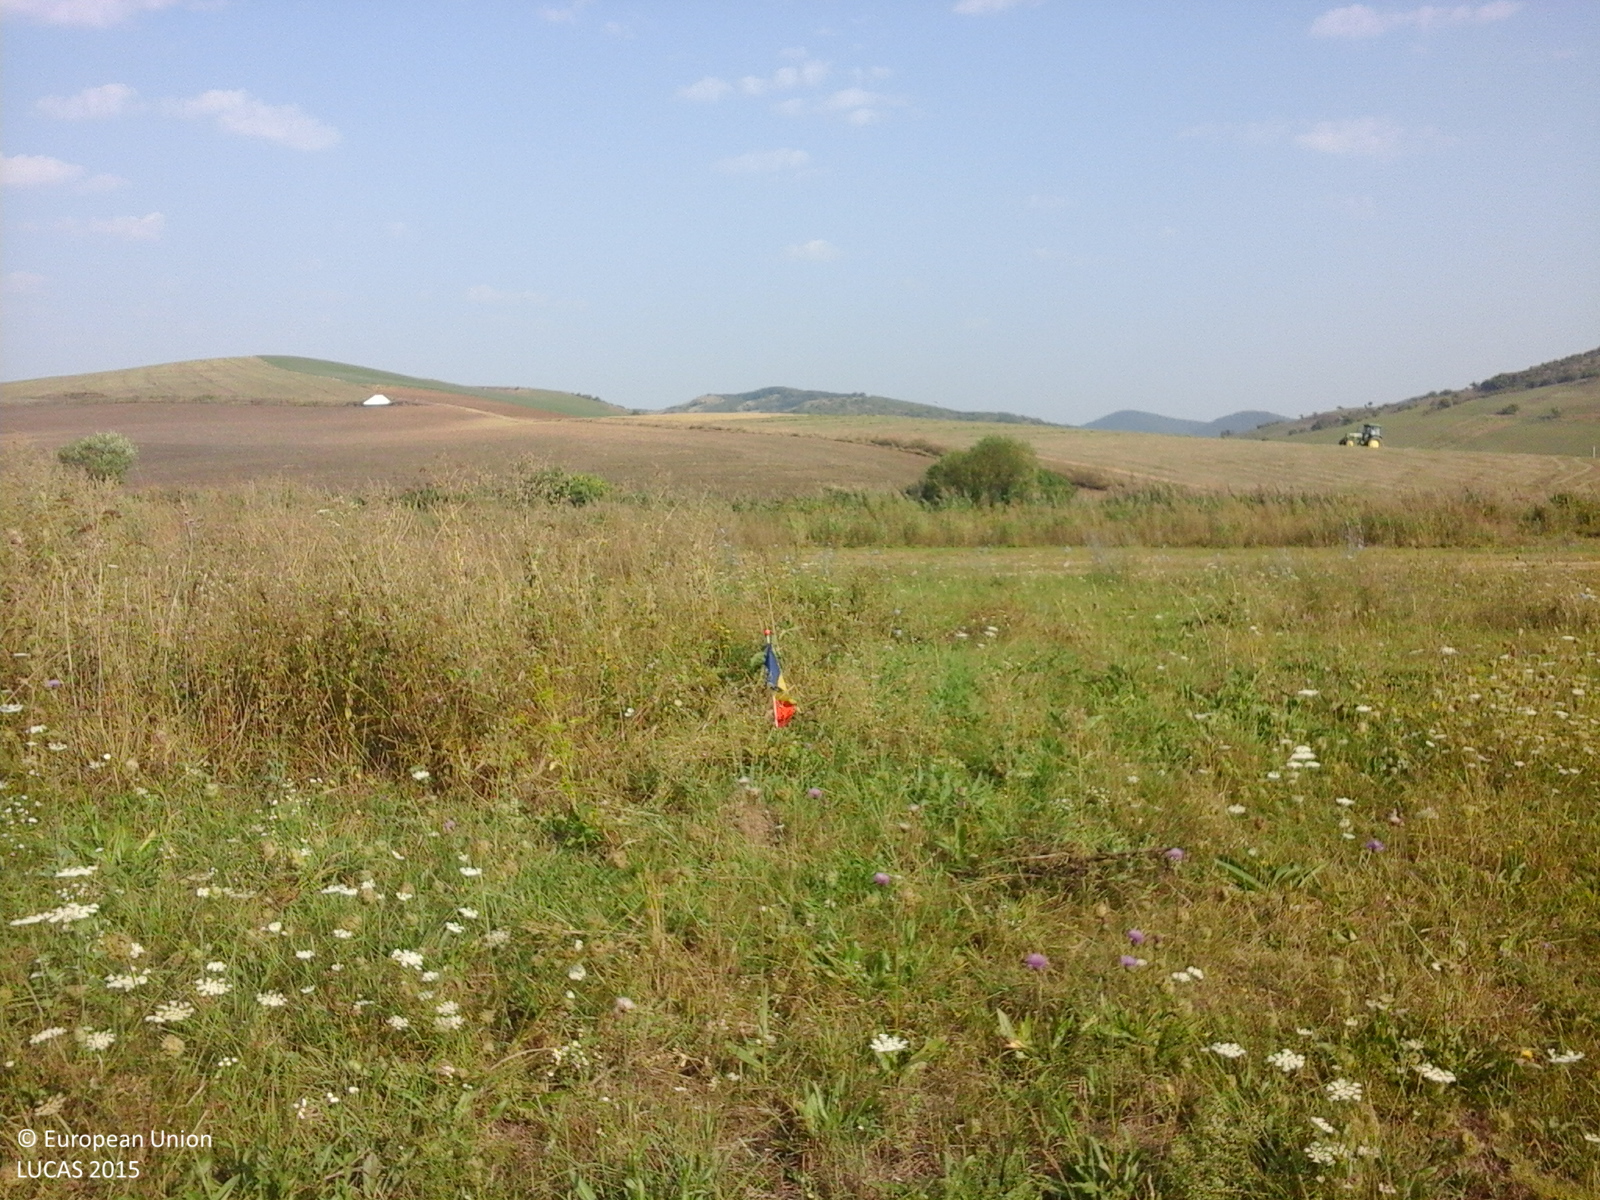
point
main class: Grassland
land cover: Spontaneously vegetated surfaces
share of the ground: > 75 %
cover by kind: herbaceous plants 100 %
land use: Fallow land
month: September
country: RO
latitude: 46.8944
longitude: 24.4877
